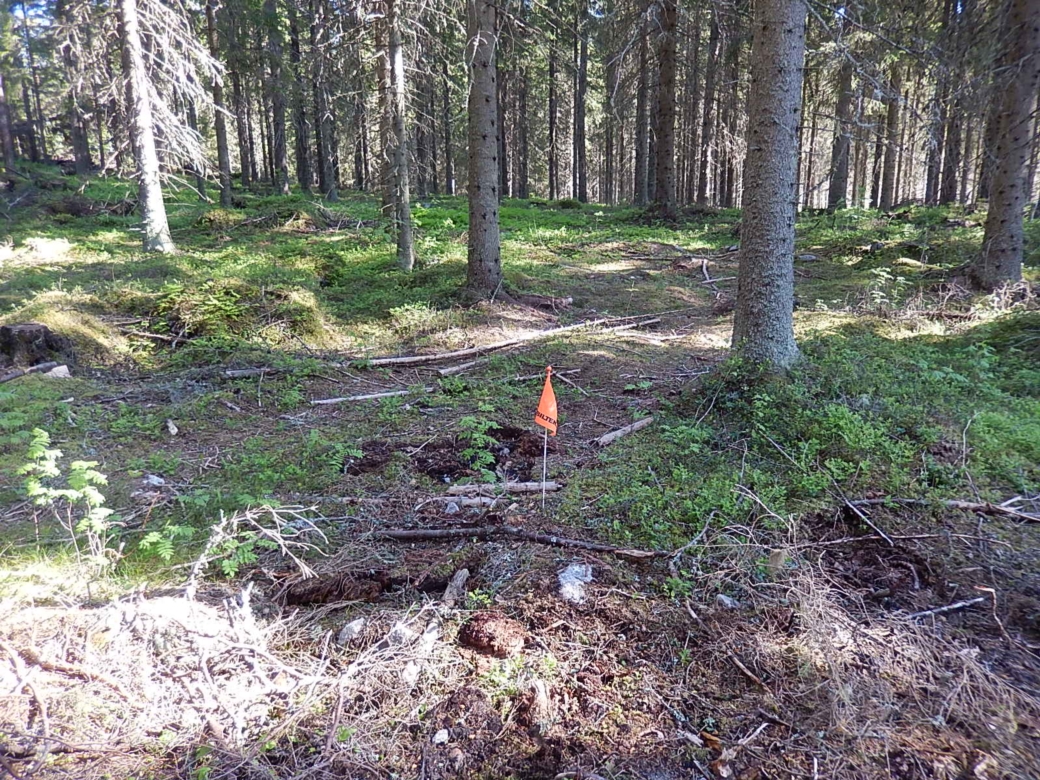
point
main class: Woodland
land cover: Spruce dominated coniferous woodland
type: boreal forest
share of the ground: > 75 %
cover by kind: coniferous forest trees 80 %, shrubs 10 %, lichens and mosses 5 %, unconsolidated bare surface 5 %
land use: Forestry
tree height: > 5 m
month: June
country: FI
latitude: 62.0455
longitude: 21.6944
